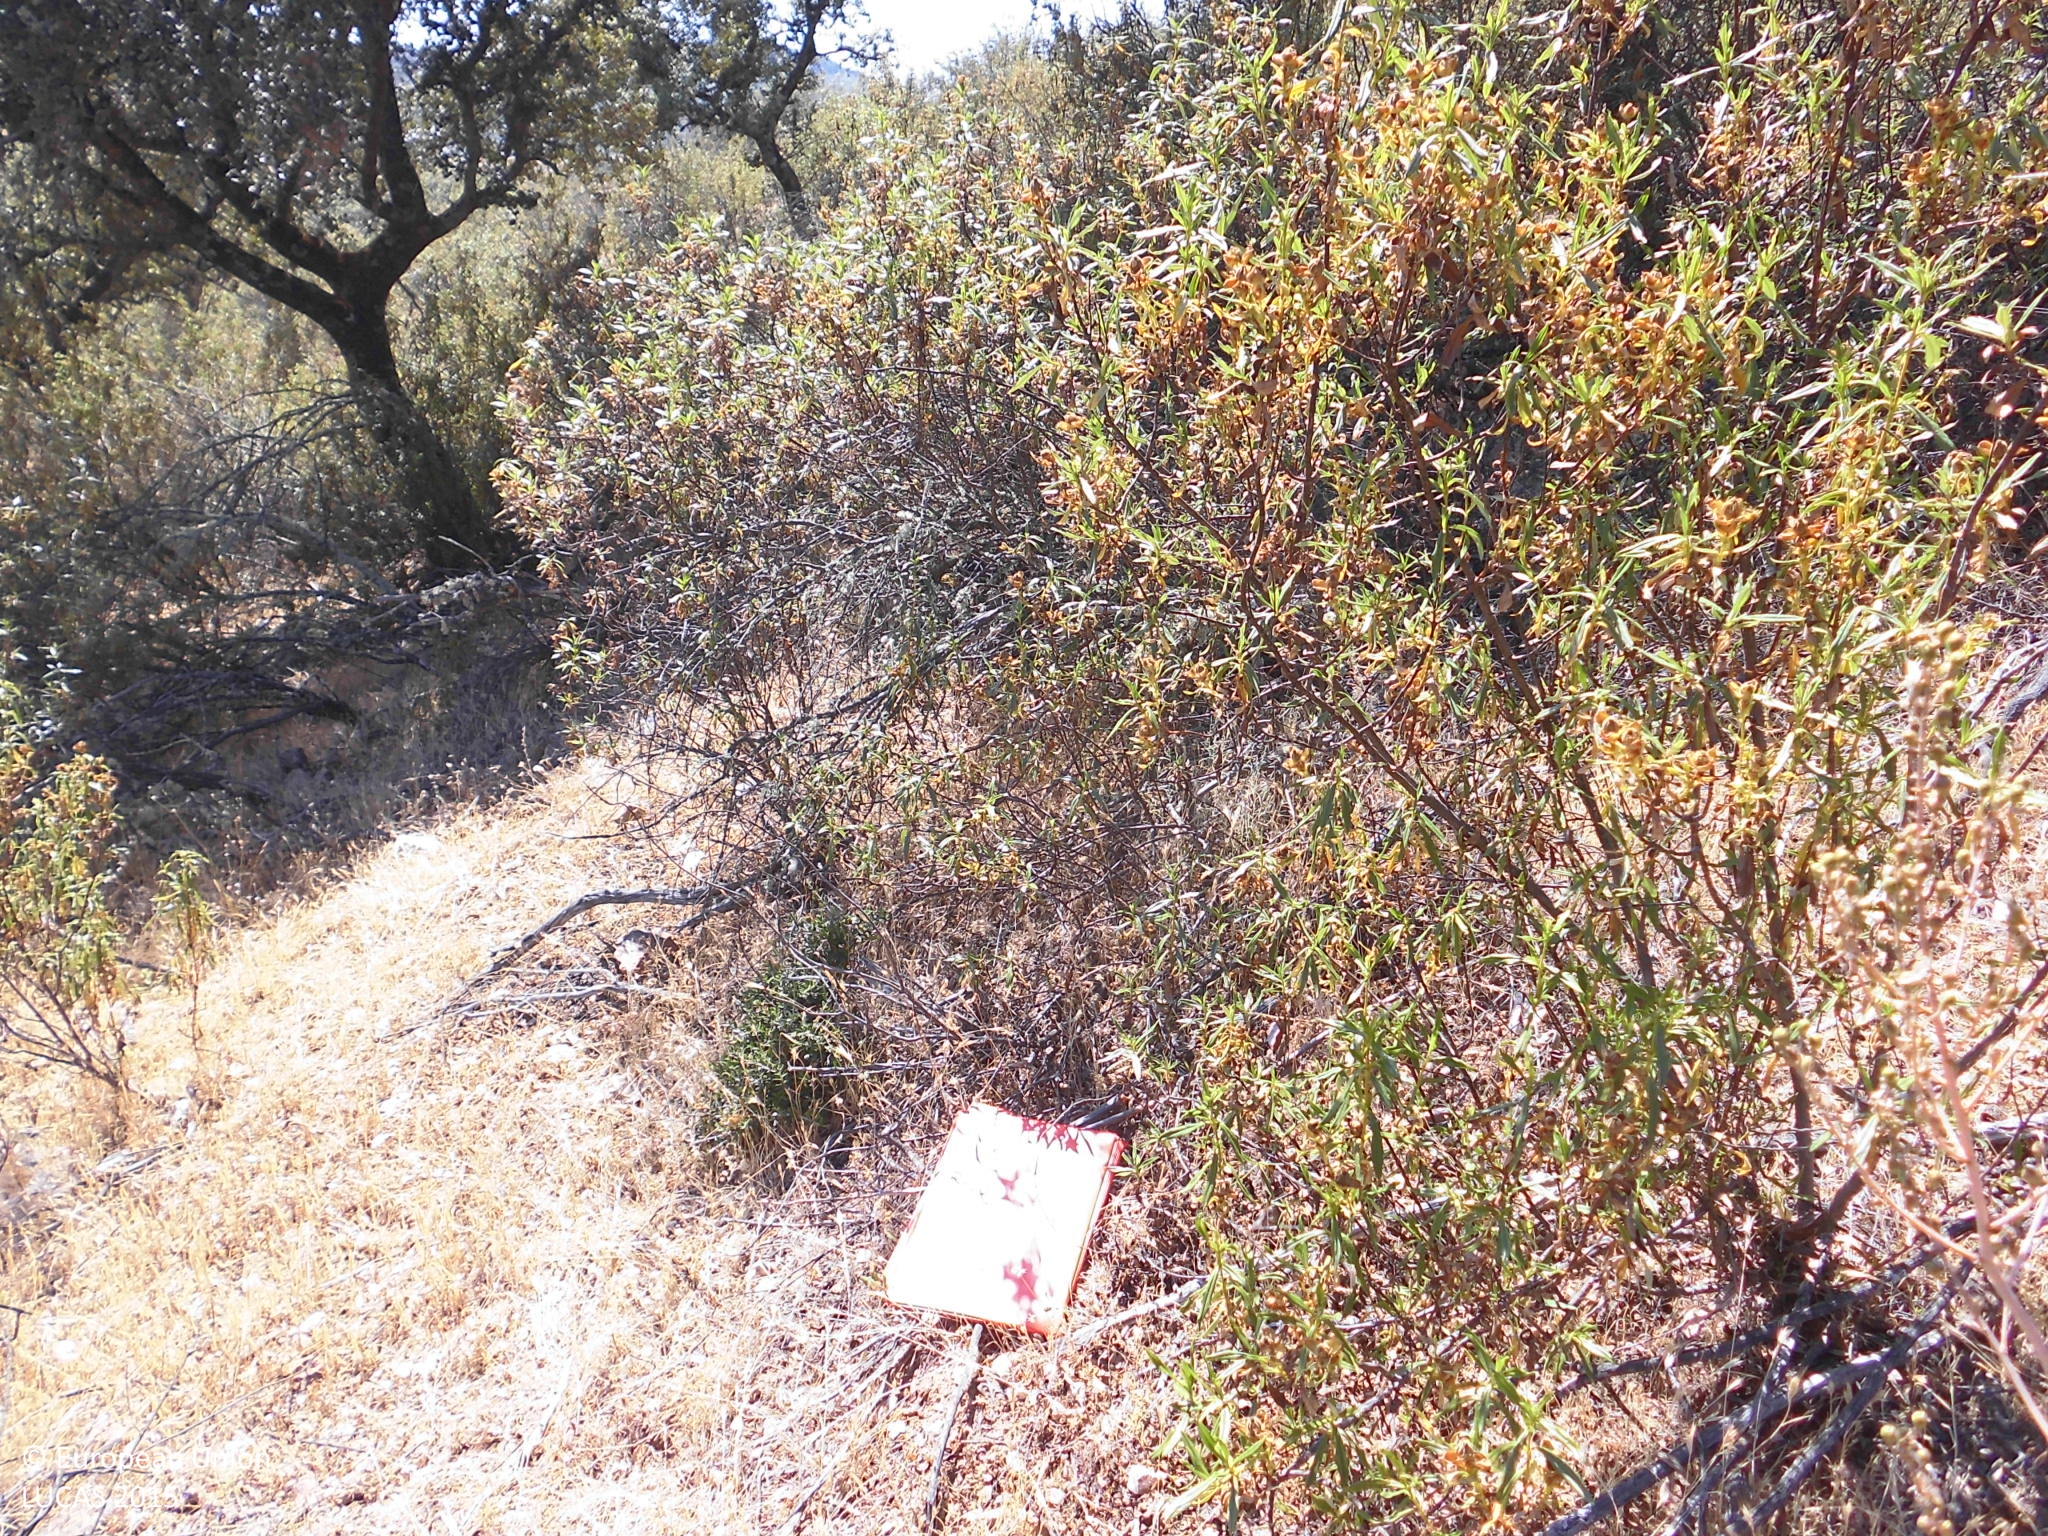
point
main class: Woodland
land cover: Broadleaved woodland
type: broadleaved evergreen forest
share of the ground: 10 - 25 %
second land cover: Shrubland without tree cover
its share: > 75 %
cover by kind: herbaceous plants 60 %, shrubs 25 %, broadleaved forest trees 15 %
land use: Forestry
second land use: Agriculture (excluding fallow land and kitchen gardens)
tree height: > 5 m
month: May
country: ES
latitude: 39.9109
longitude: -6.7053
